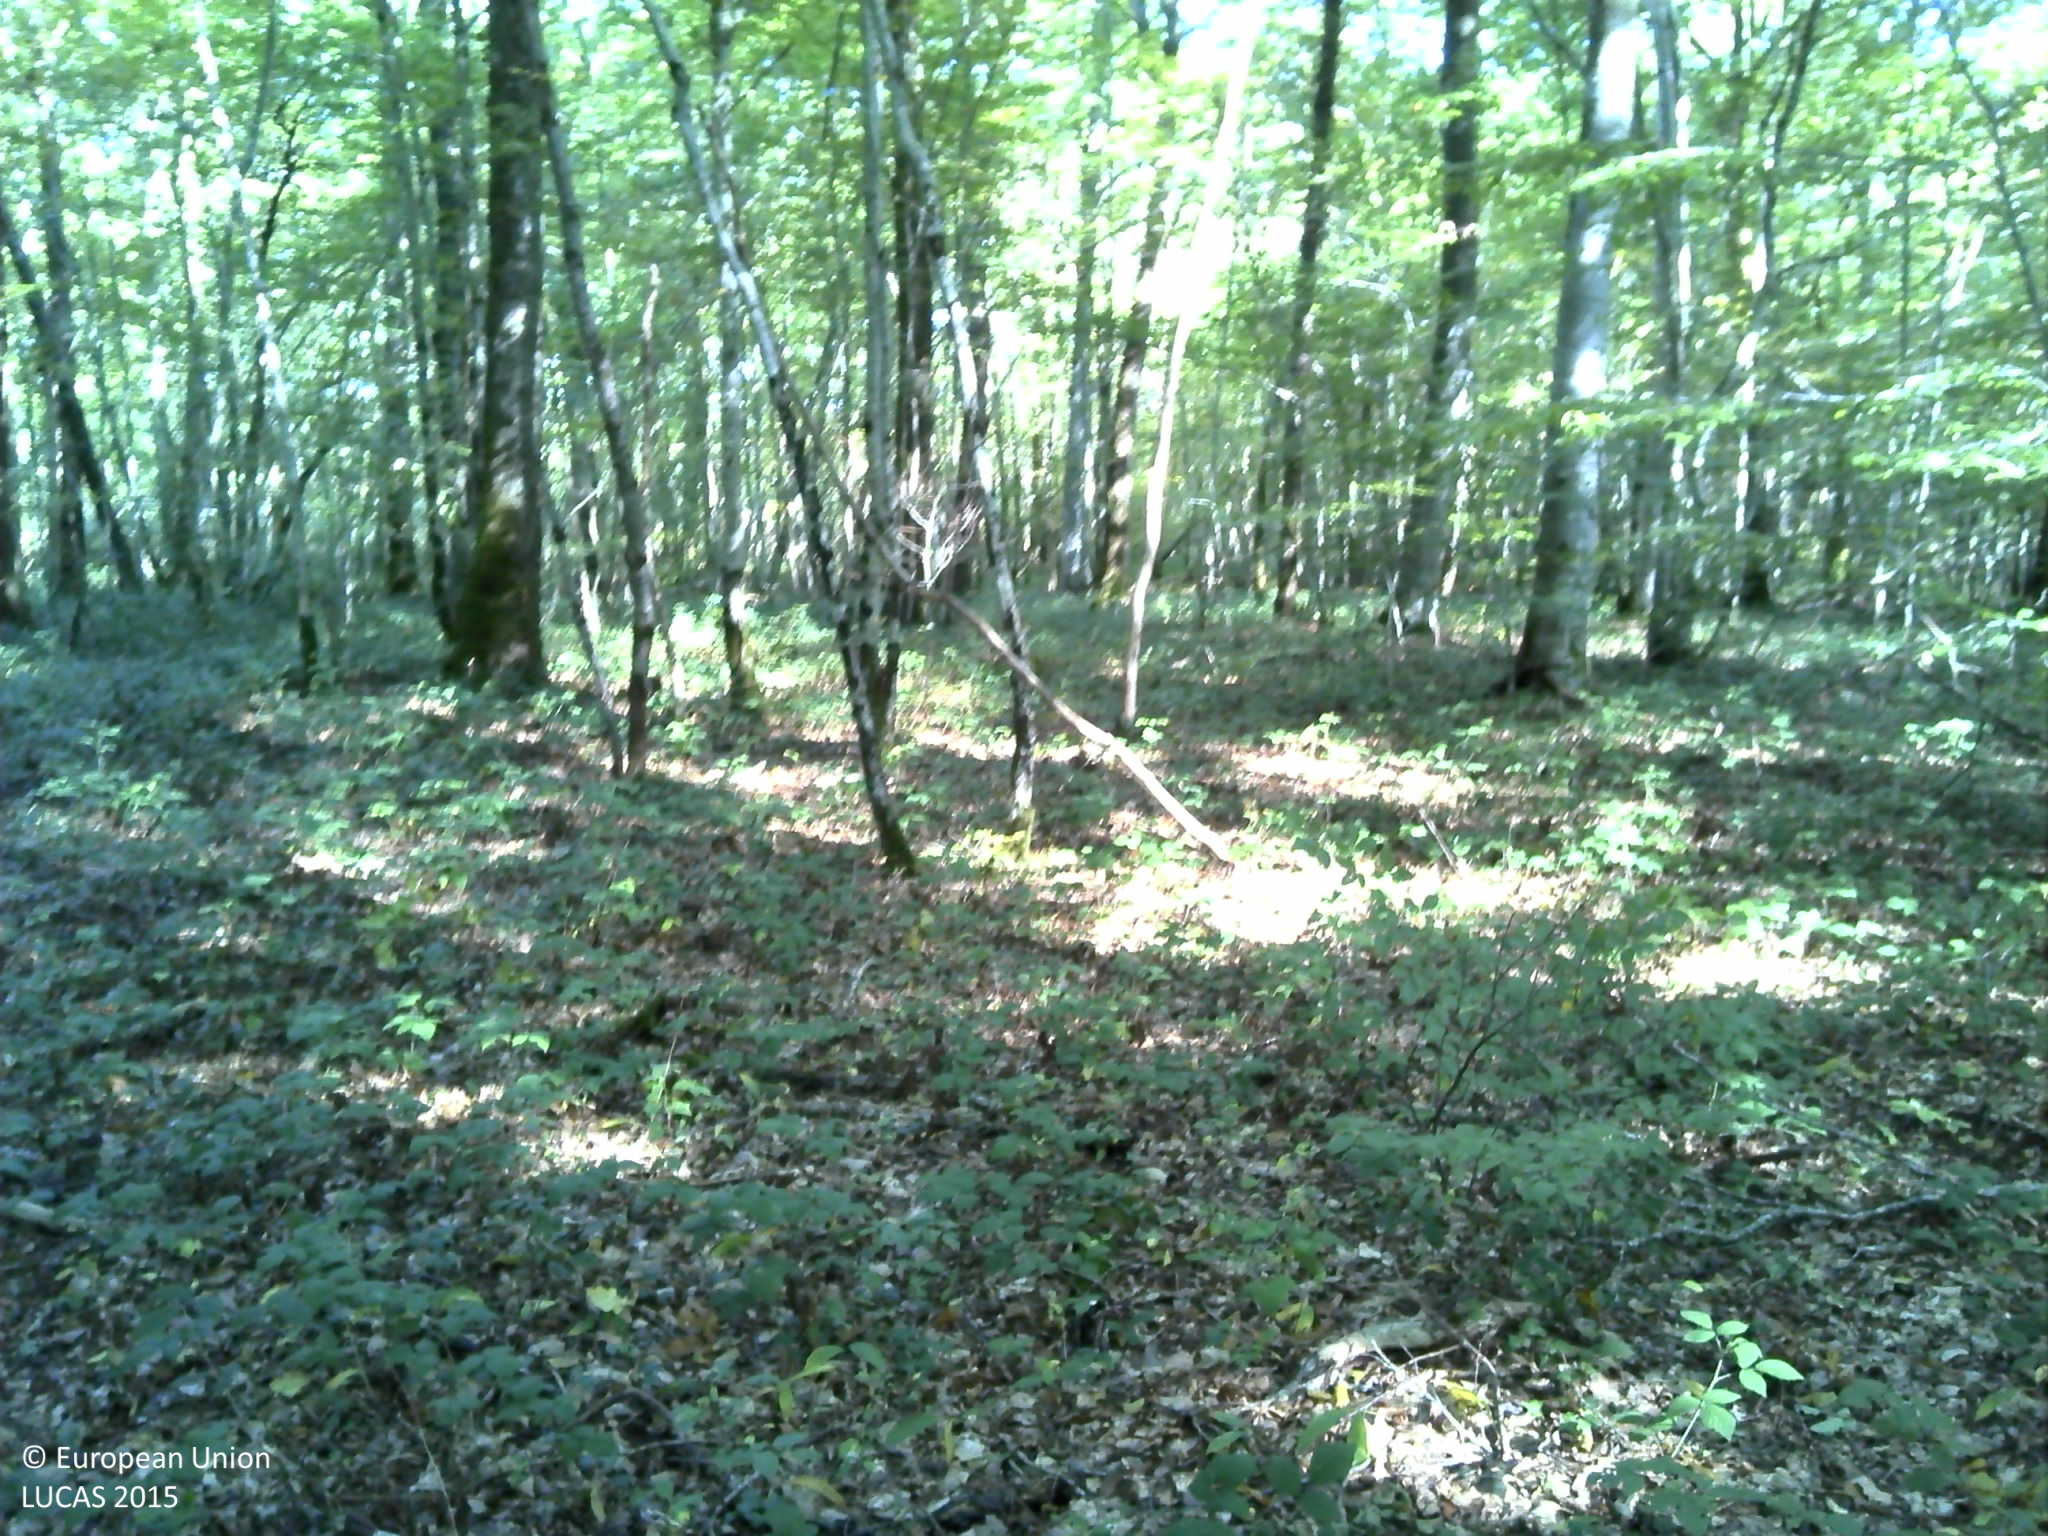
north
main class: Woodland
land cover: Broadleaved woodland
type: mesophytic deciduous forest
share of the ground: > 75 %
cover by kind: broadleaved forest trees 85 %, herbaceous plants 10 %, lichens and mosses 5 %
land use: Forestry
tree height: > 5 m
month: September
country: FR
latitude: 46.8736
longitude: 4.4242
